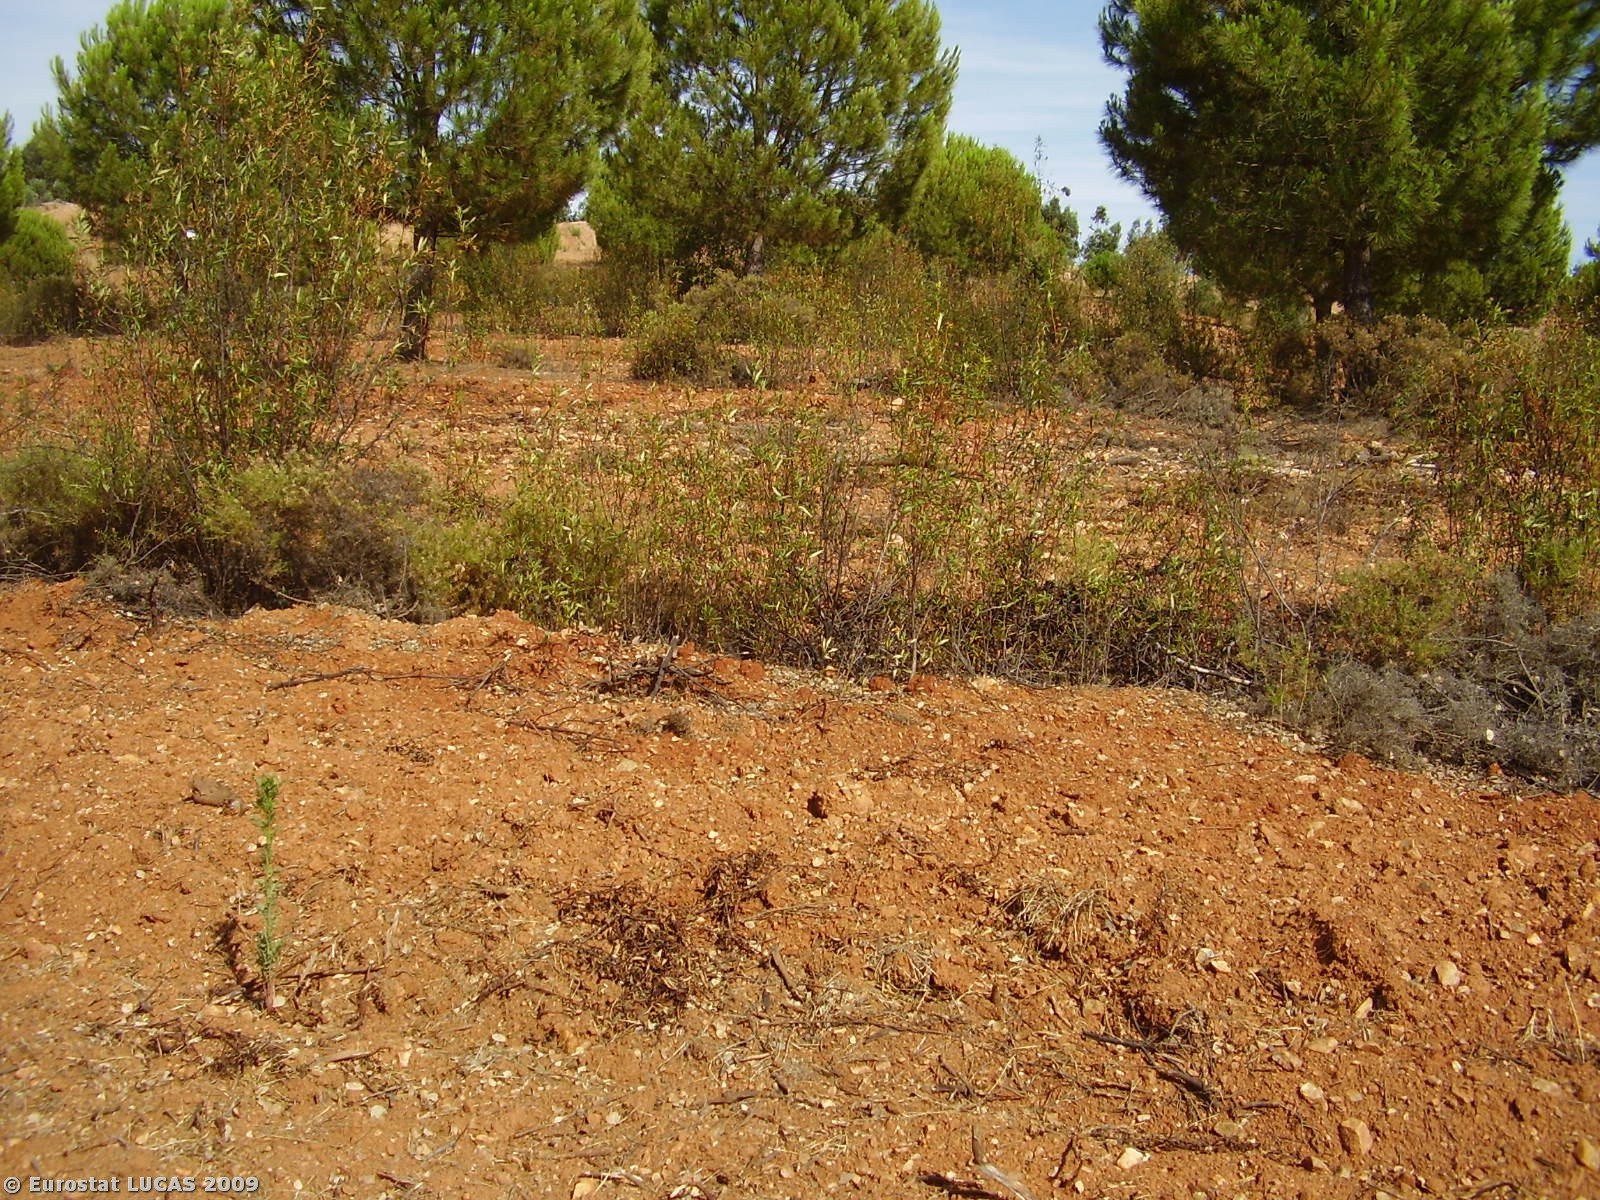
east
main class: Woodland
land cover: Coniferous woodland
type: coniferous forest of the mediterranean region
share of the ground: 10 - 25 %
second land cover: Bare land
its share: 50 - 75 %
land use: Forestry
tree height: > 5 m
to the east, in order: Coniferous woodland; Bare land; Coniferous woodland; Rivers and streams; Coniferous woodland; Tracks; Single bushes/trees; Tracks; Broadleaved woodland; Tracks; Broadleaved woodland; Tracks; Fences; Bare land; Grassland without tree/shrub cover; Tracks; Grassland without tree/shrub cover
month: July
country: PT
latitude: 38.5615
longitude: -7.7431
